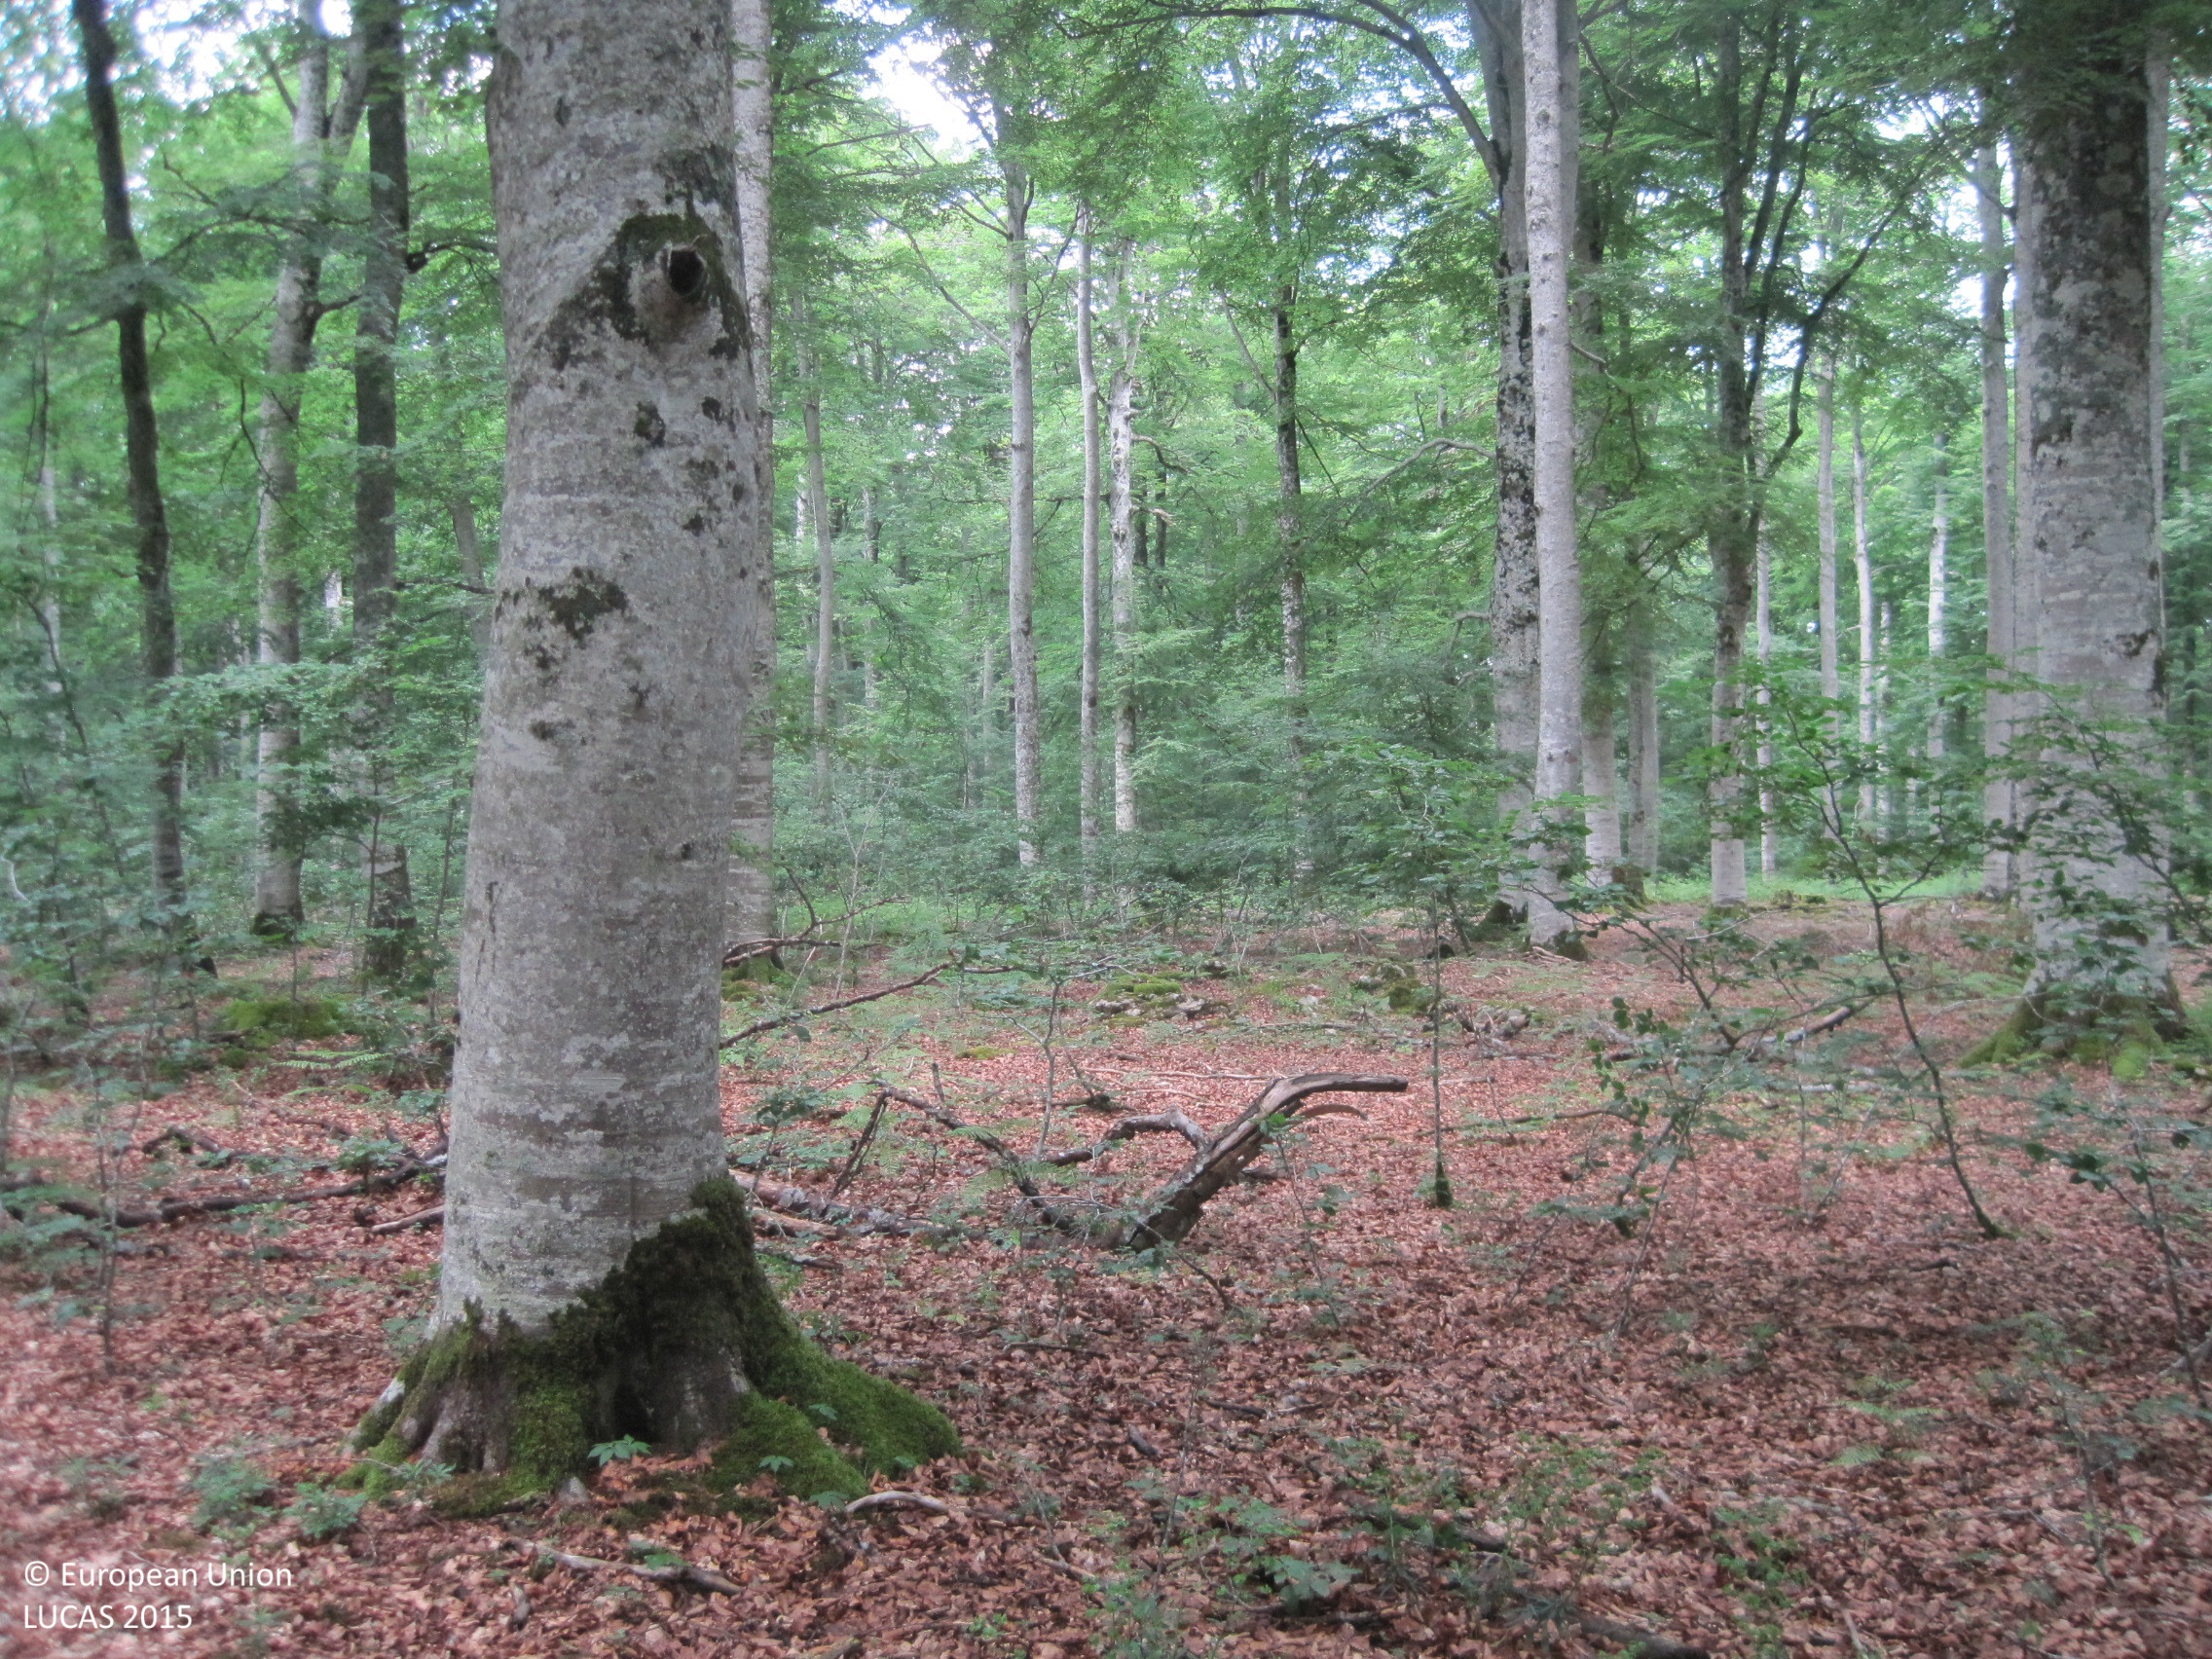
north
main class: Woodland
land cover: Broadleaved woodland
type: beech forest
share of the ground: > 75 %
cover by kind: broadleaved forest trees 100 %
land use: Forestry
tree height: > 5 m
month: June
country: ES
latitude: 42.8029
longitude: -2.2366
